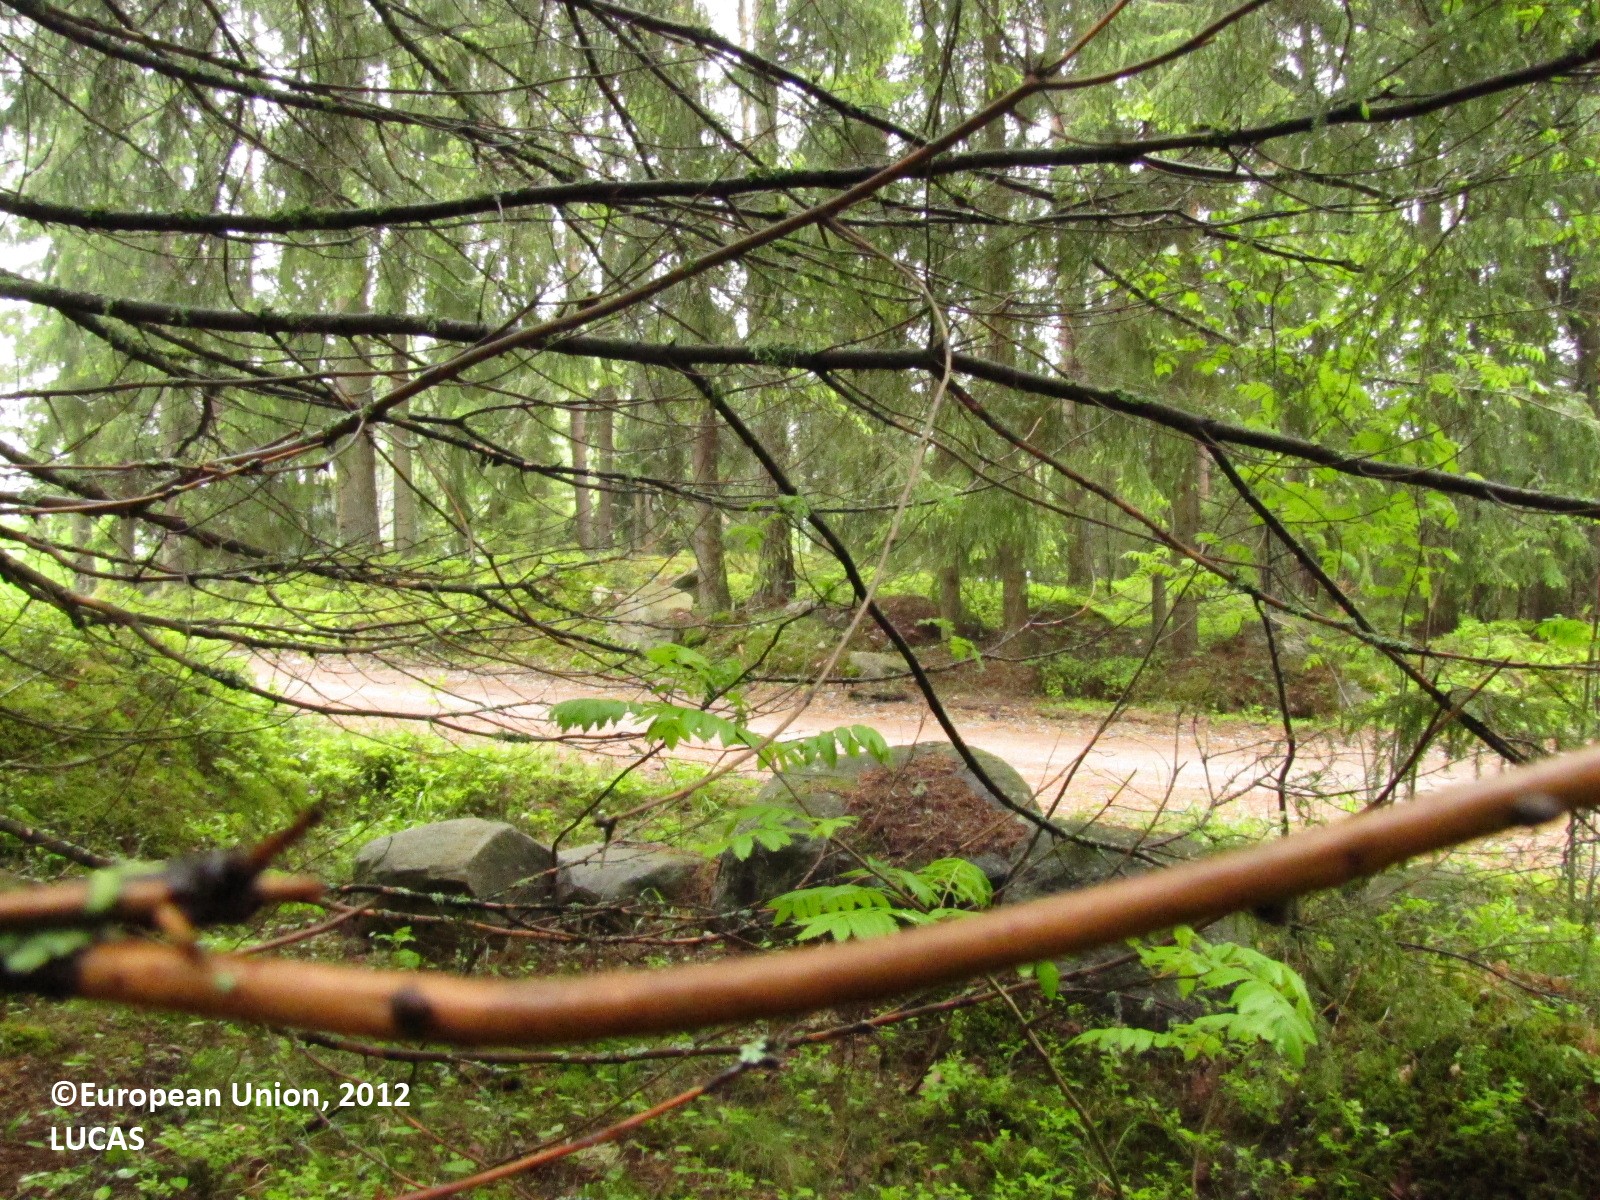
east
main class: Woodland
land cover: Spruce dominated coniferous woodland
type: hemiboreal forest and nemoral coniferous forest and mixed broadleaved-coniferous forest
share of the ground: > 75 %
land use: Forestry
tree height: > 5 m
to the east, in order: Spruce dominated coniferous woodland; Tracks; Spruce dominated coniferous woodland; Electric lines; Artificial constructions in urban areas; Grassland without tree/shrub cover; Pine dominated coniferous woodland; Shrubland with sparse tree cover; Temporary grasslands; Broadleaved woodland; Pine dominated mixed woodland; Inland marshes; Inland water bodies
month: June
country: FI
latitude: 61.4809
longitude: 22.9692
